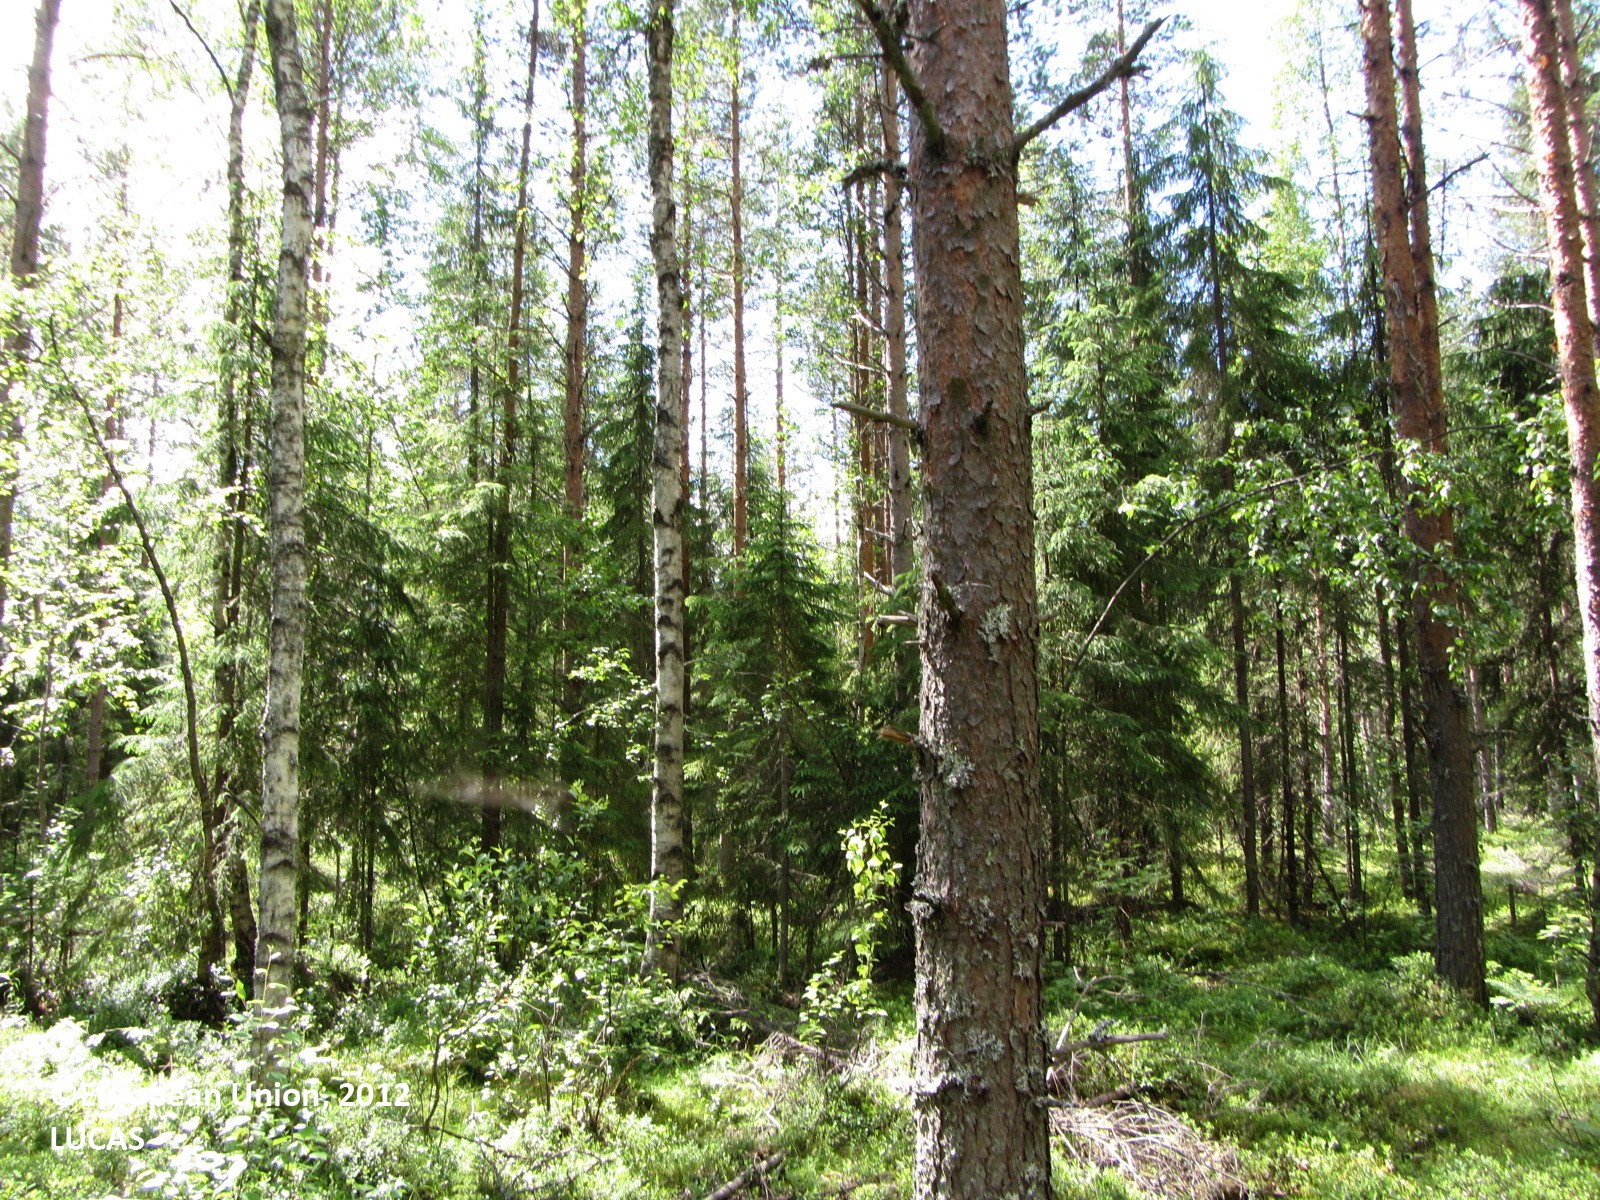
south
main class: Woodland
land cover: Other mixed woodland
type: boreal forest
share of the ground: > 75 %
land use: Forestry
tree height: > 5 m
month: July
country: FI
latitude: 62.8335
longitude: 25.5200
